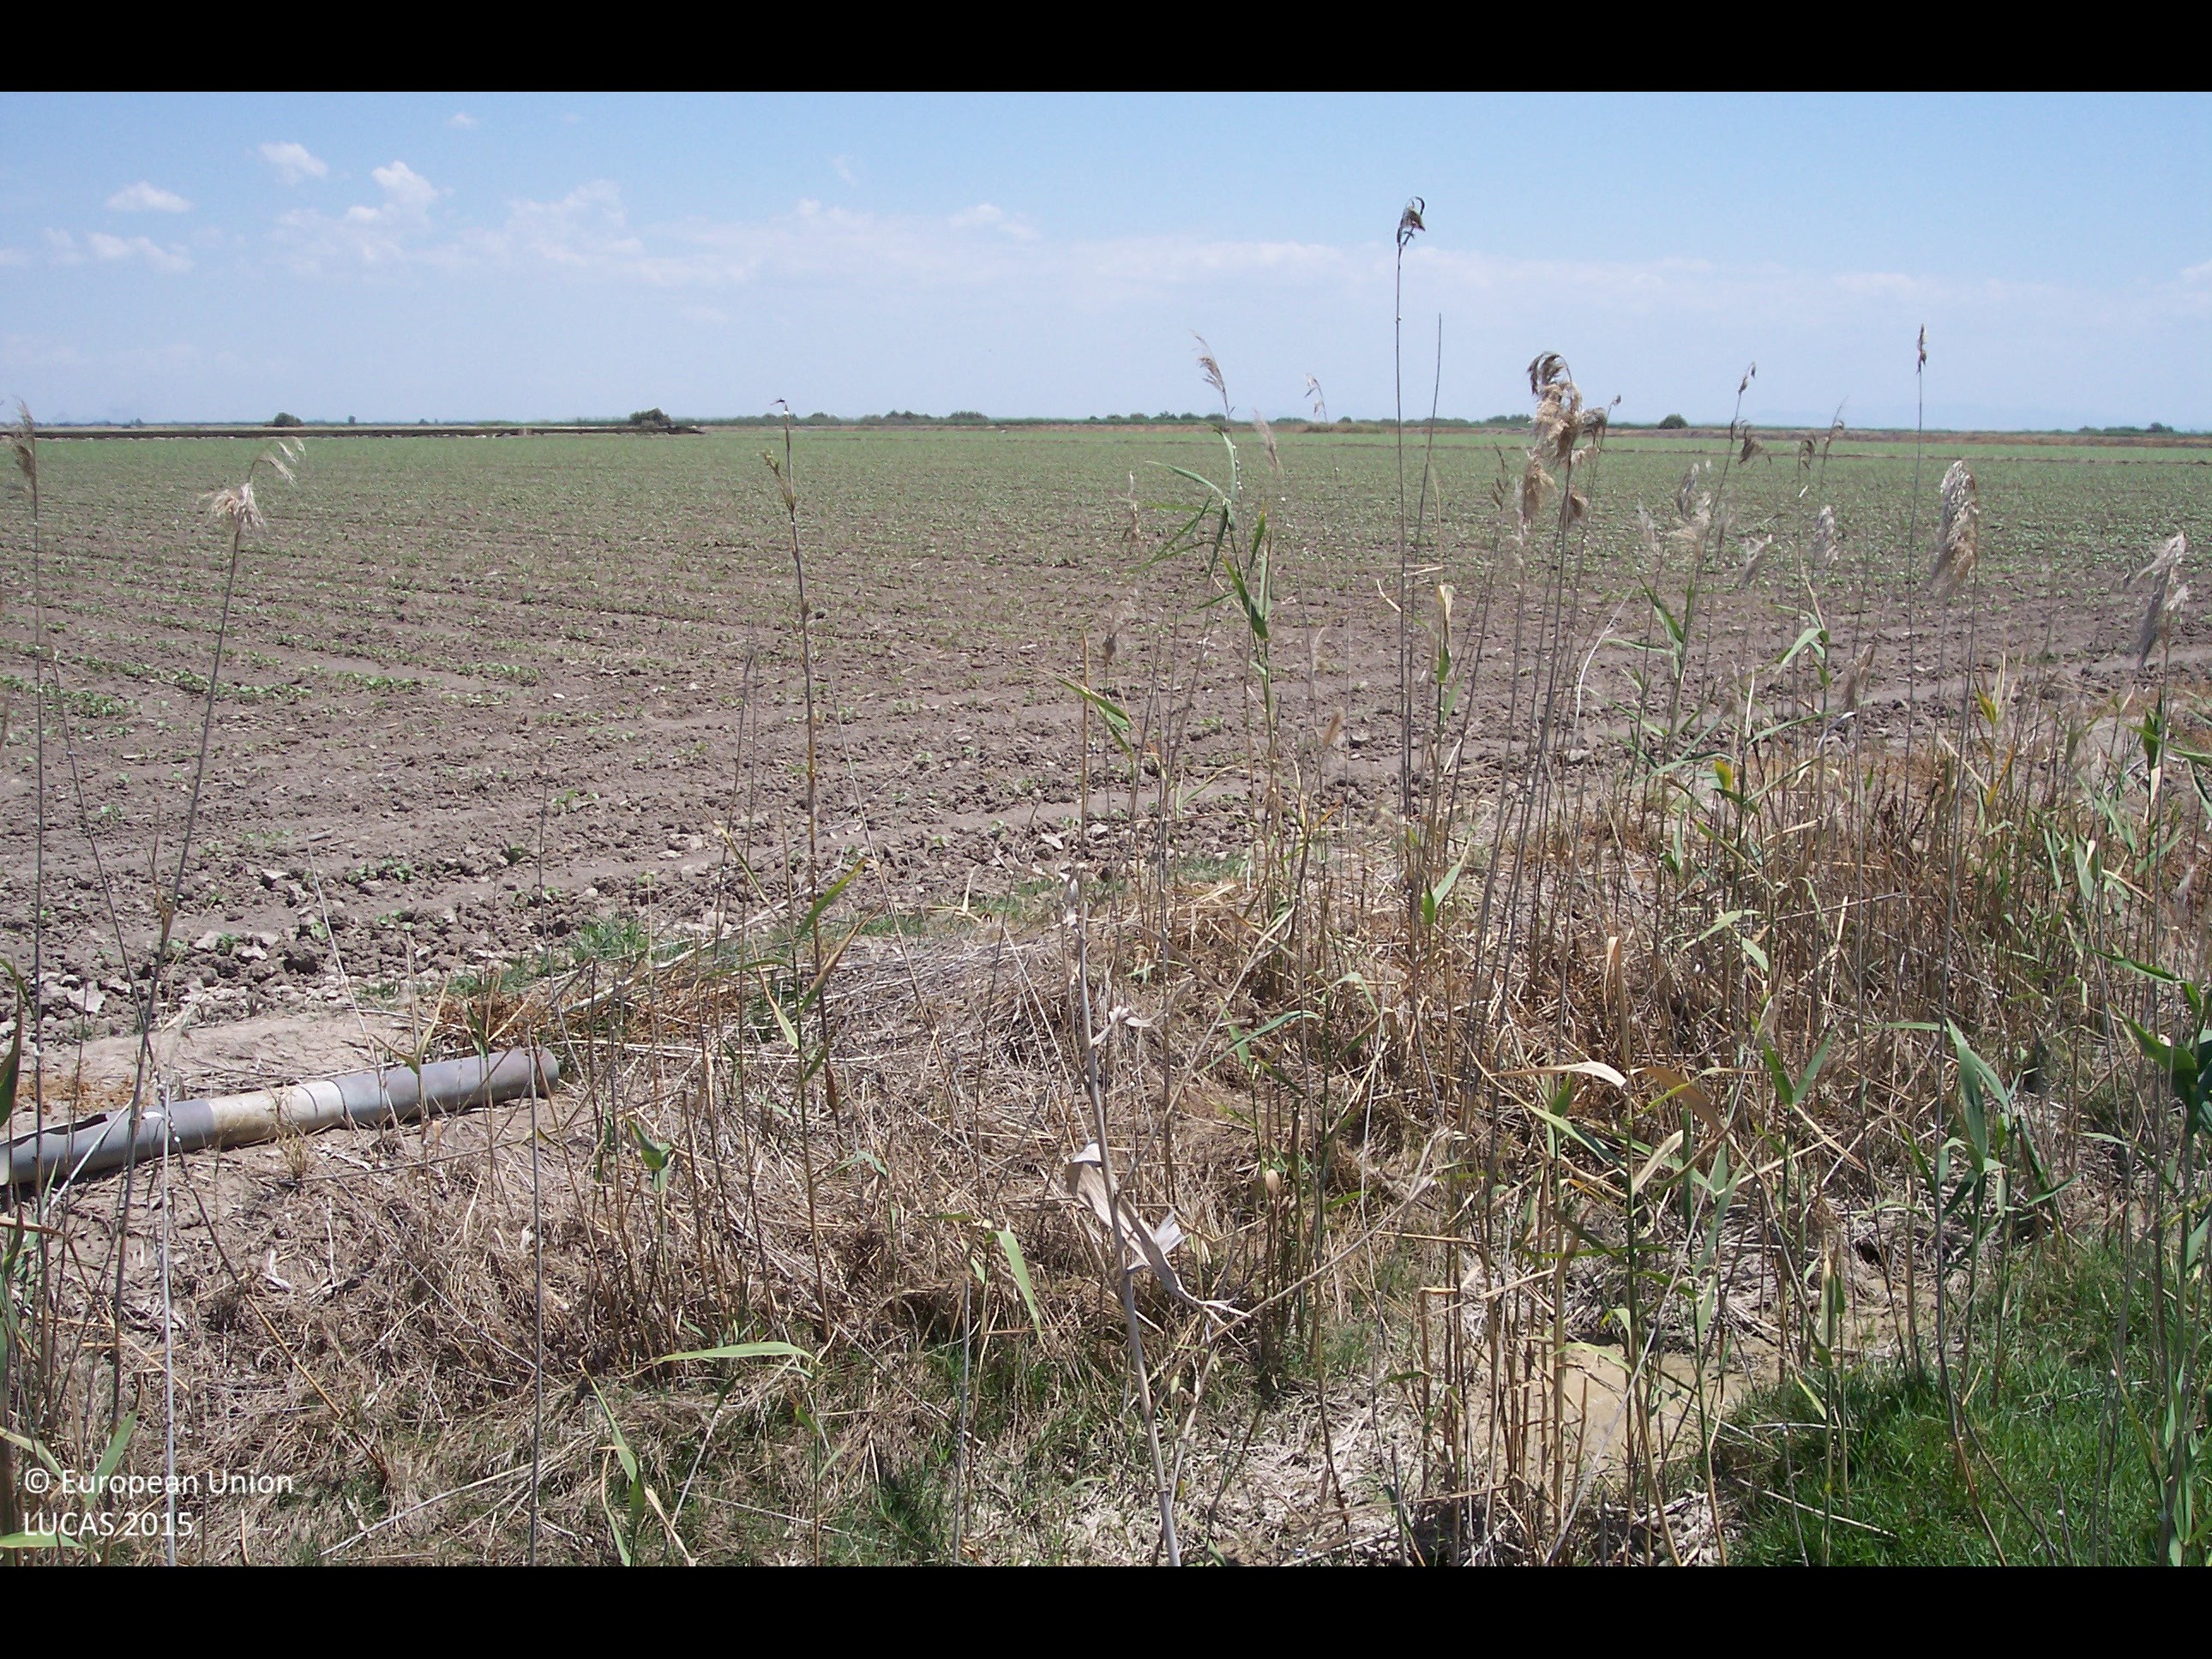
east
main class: Cropland
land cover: Sunflower
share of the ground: > 75 %
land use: Agriculture (excluding fallow land and kitchen gardens)
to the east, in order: Sunflower; Tracks; Ditches and canals; Sunflower
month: May
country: ES
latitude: 37.1861
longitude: -6.0502
